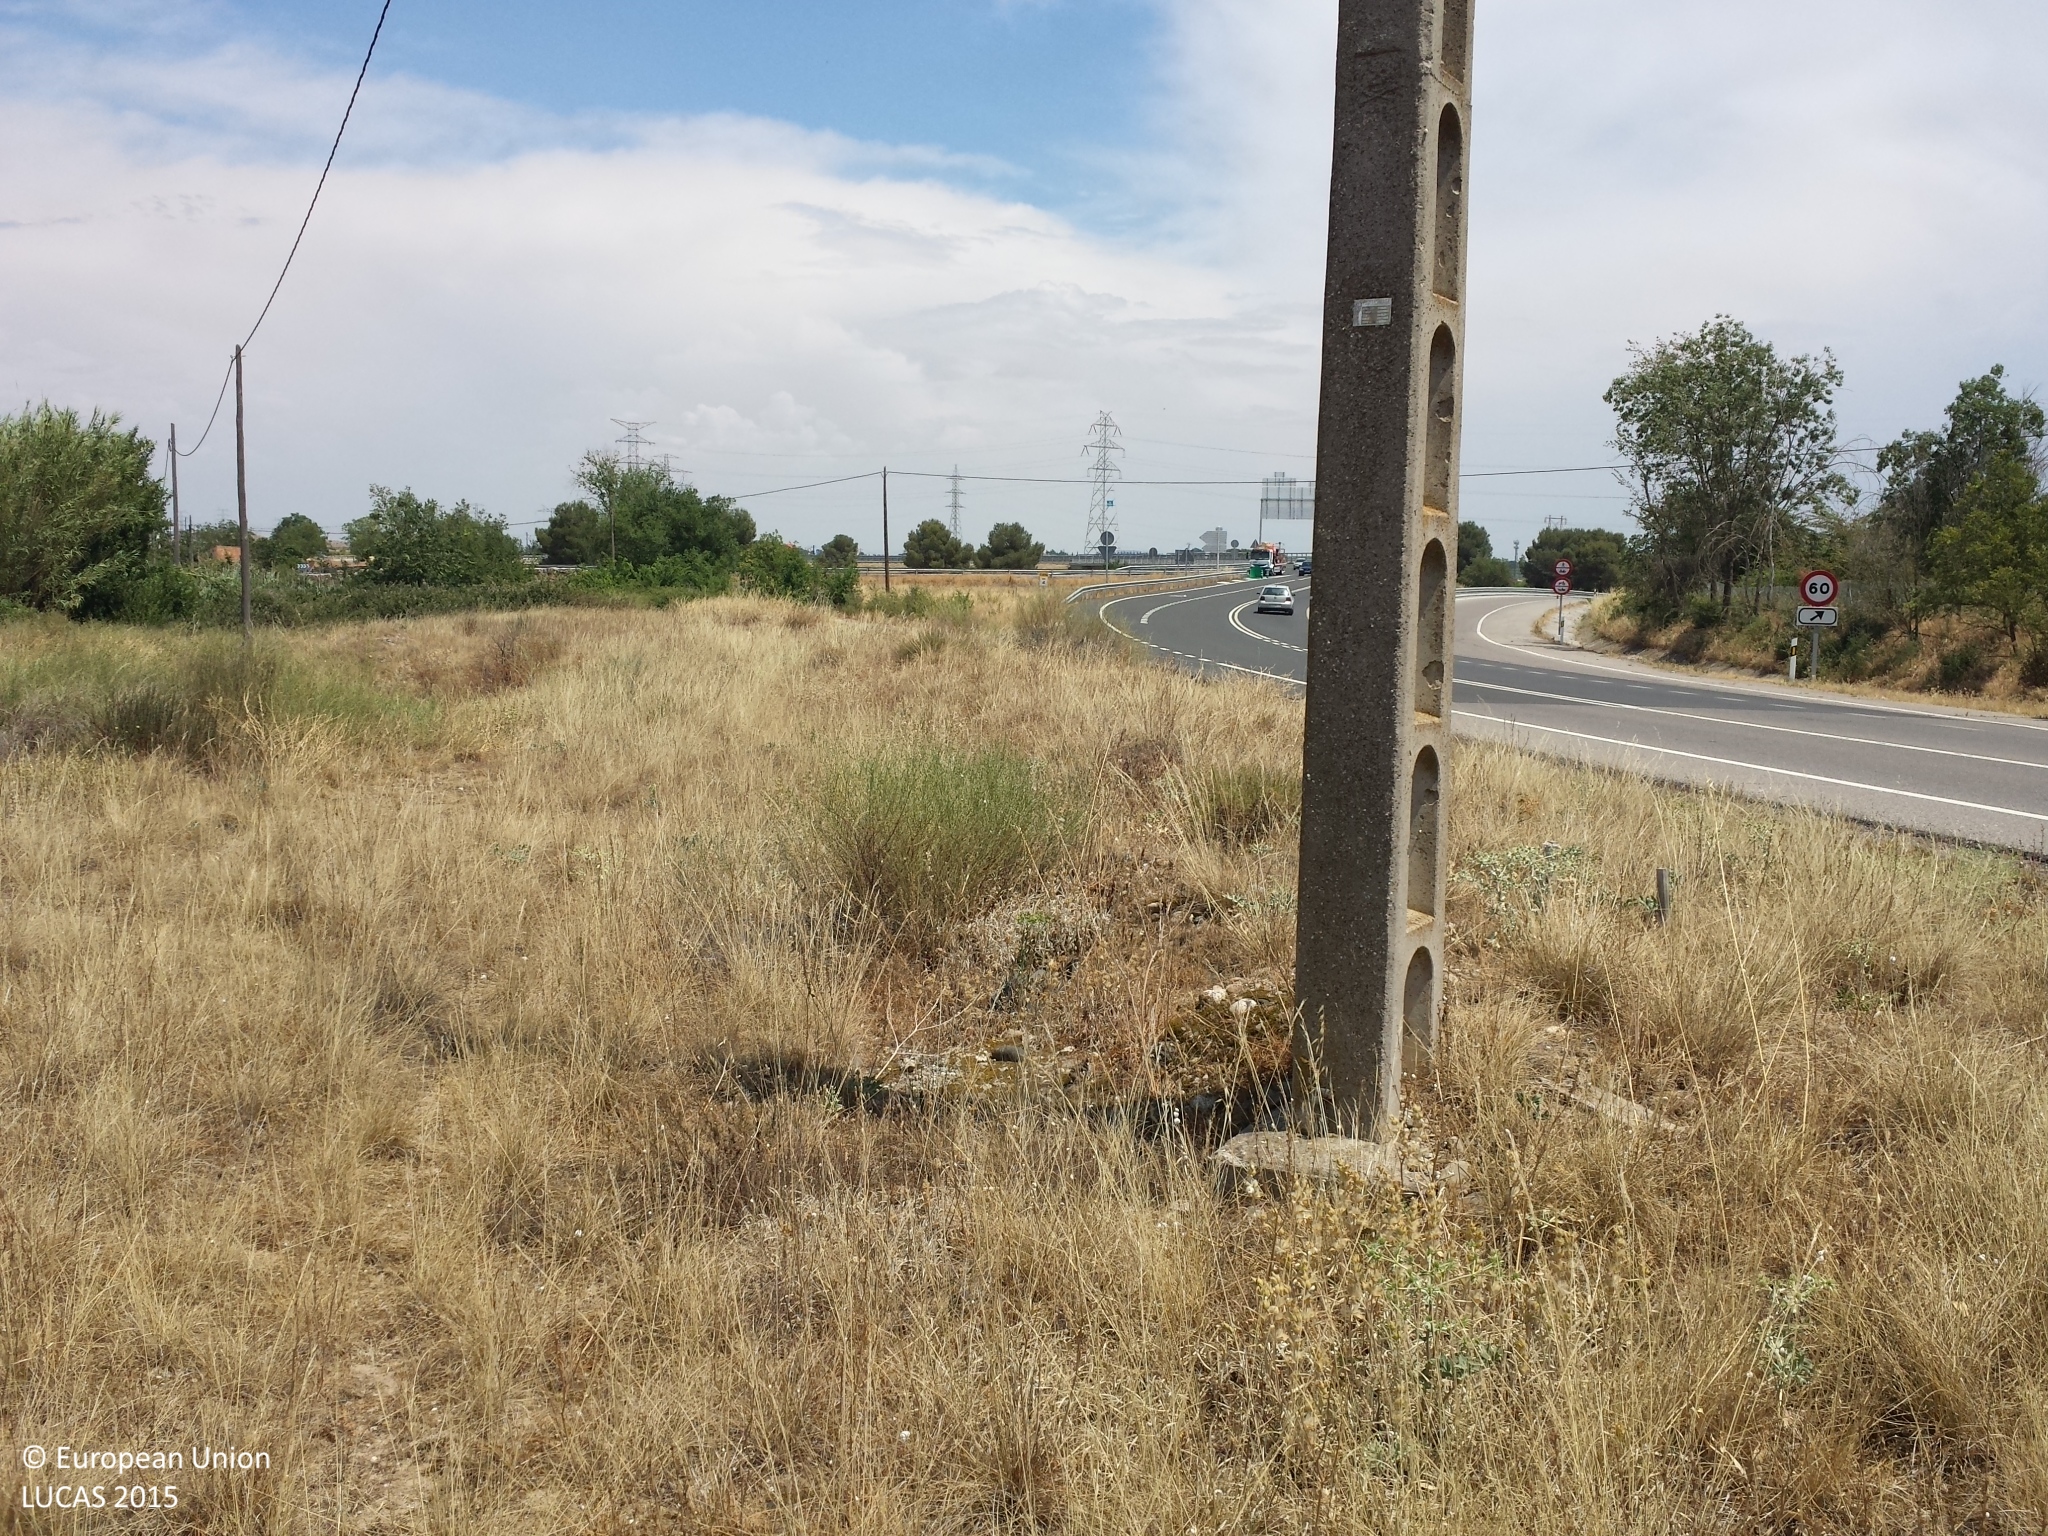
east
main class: Grassland
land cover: Grassland without tree/shrub cover
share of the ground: > 75 %
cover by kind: herbaceous plants 85 %, consolidated bare surface 10 %, shrubs 5 %
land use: Semi-natural and natural areas not in use
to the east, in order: Grassland without tree/shrub cover; Electric lines; Grassland without tree/shrub cover; Paved roads, cycling and walking lanes; Fences; Electric lines; Grass margins; Grassland without tree/shrub cover; Broadleaved woodland; Fences; Paved roads, cycling and walking lanes; Grassland with sparse tree/shrub cover
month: June
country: ES
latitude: 41.5818
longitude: 0.6202
